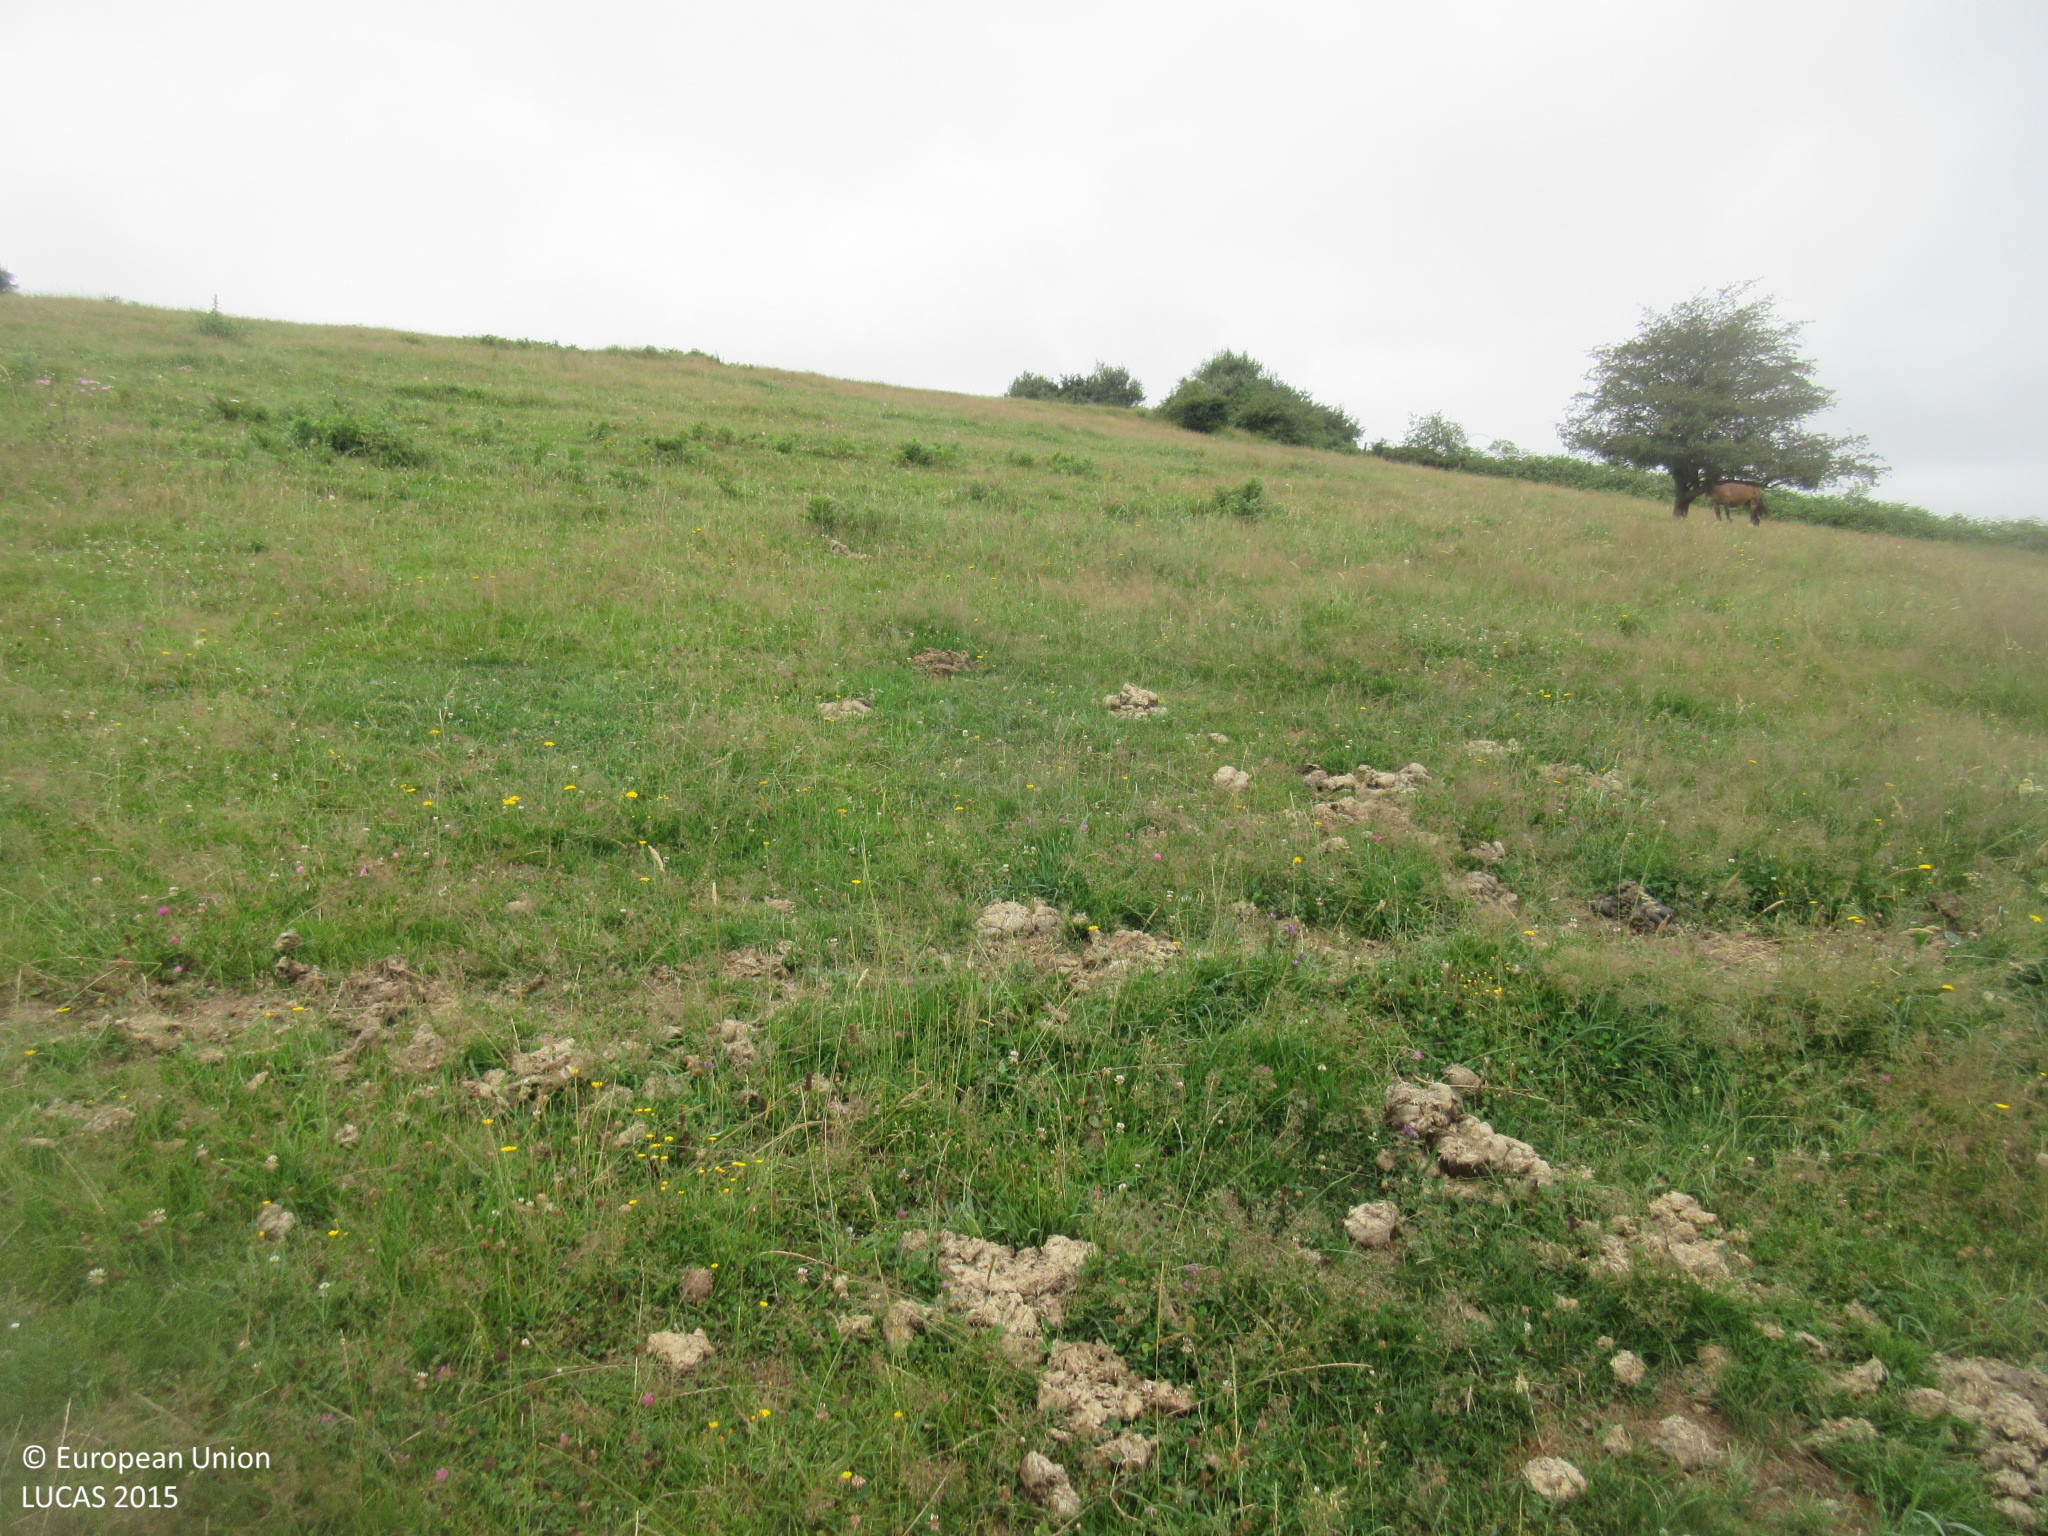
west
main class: Grassland
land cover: Grassland without tree/shrub cover
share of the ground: > 75 %
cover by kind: herbaceous plants 100 %
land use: Agriculture (excluding fallow land and kitchen gardens)
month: July
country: ES
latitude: 43.2054
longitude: -3.5192
